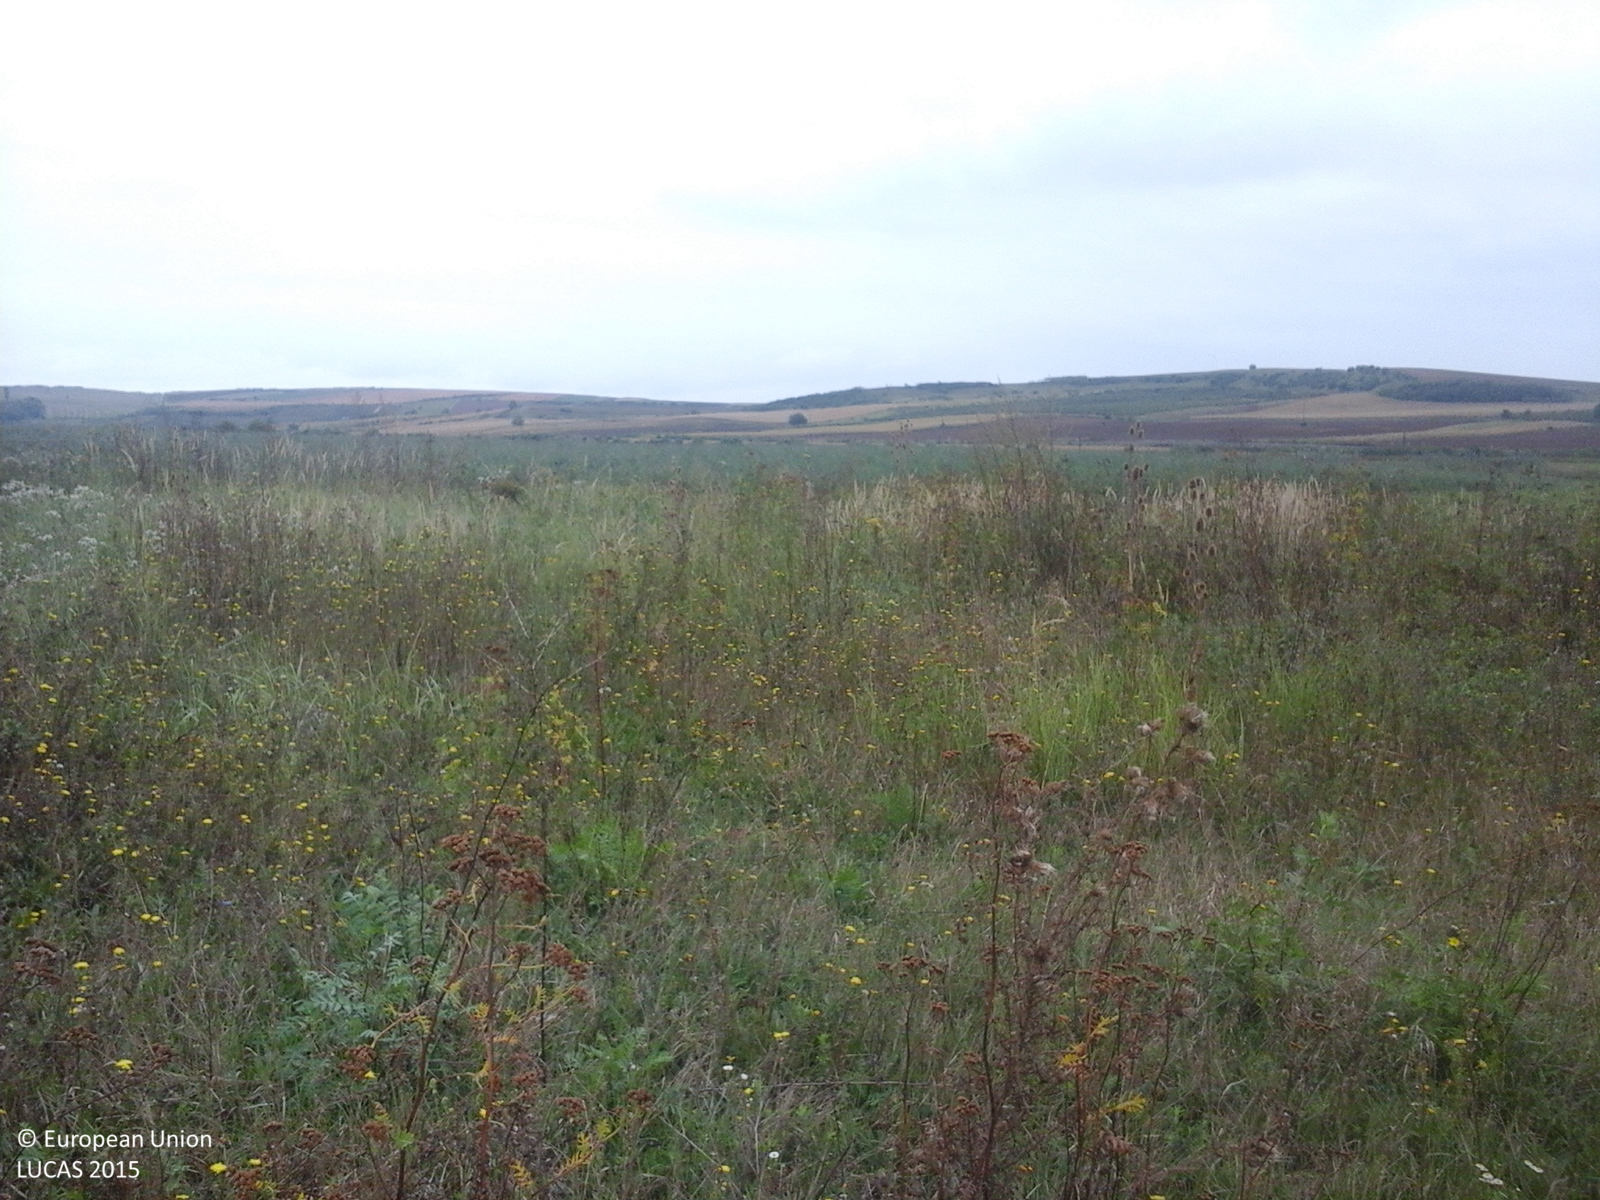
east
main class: Cropland
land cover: Maize
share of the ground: > 75 %
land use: Agriculture (excluding fallow land and kitchen gardens)
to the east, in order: Maize; Tracks; Lucerne; Ditches and canals; Grassland without tree/shrub cover
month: September
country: RO
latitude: 47.3085
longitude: 22.0196
